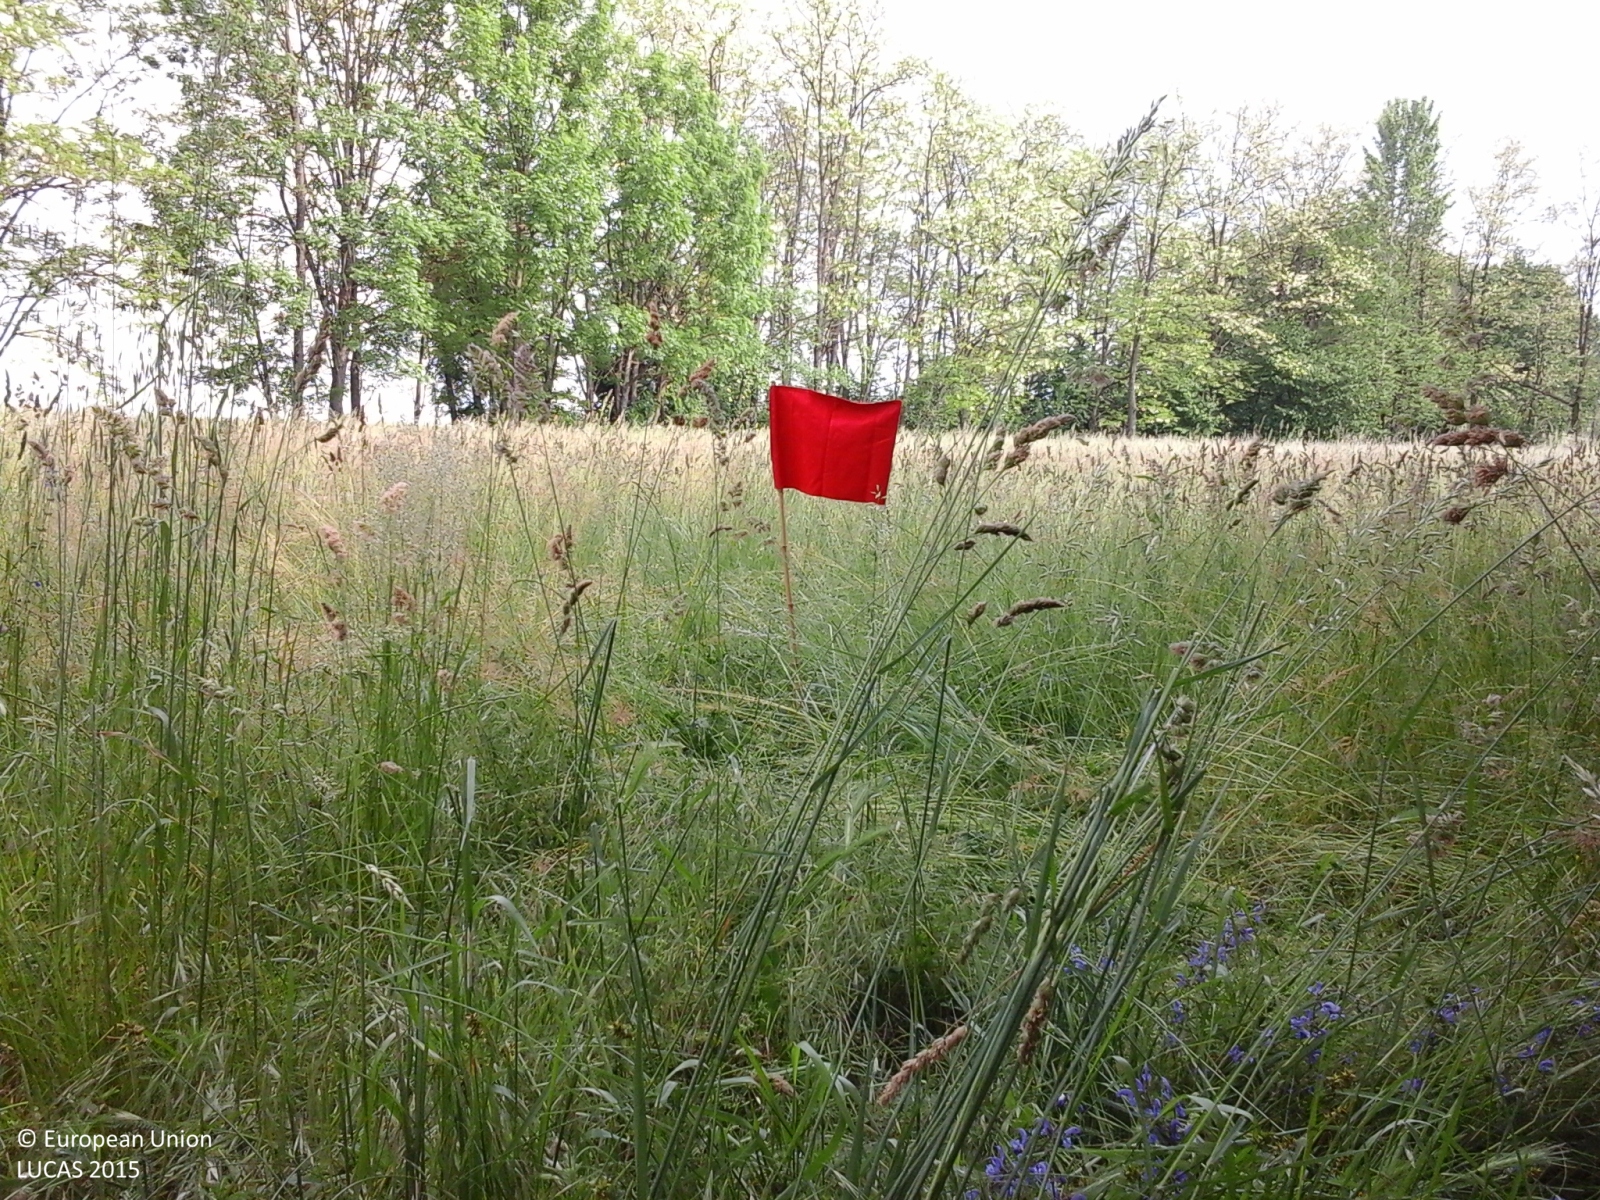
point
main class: Grassland
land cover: Grassland without tree/shrub cover
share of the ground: > 75 %
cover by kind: herbaceous plants 100 %
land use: Agriculture (excluding fallow land and kitchen gardens)
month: May
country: IT
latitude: 44.9027
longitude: 8.7993
